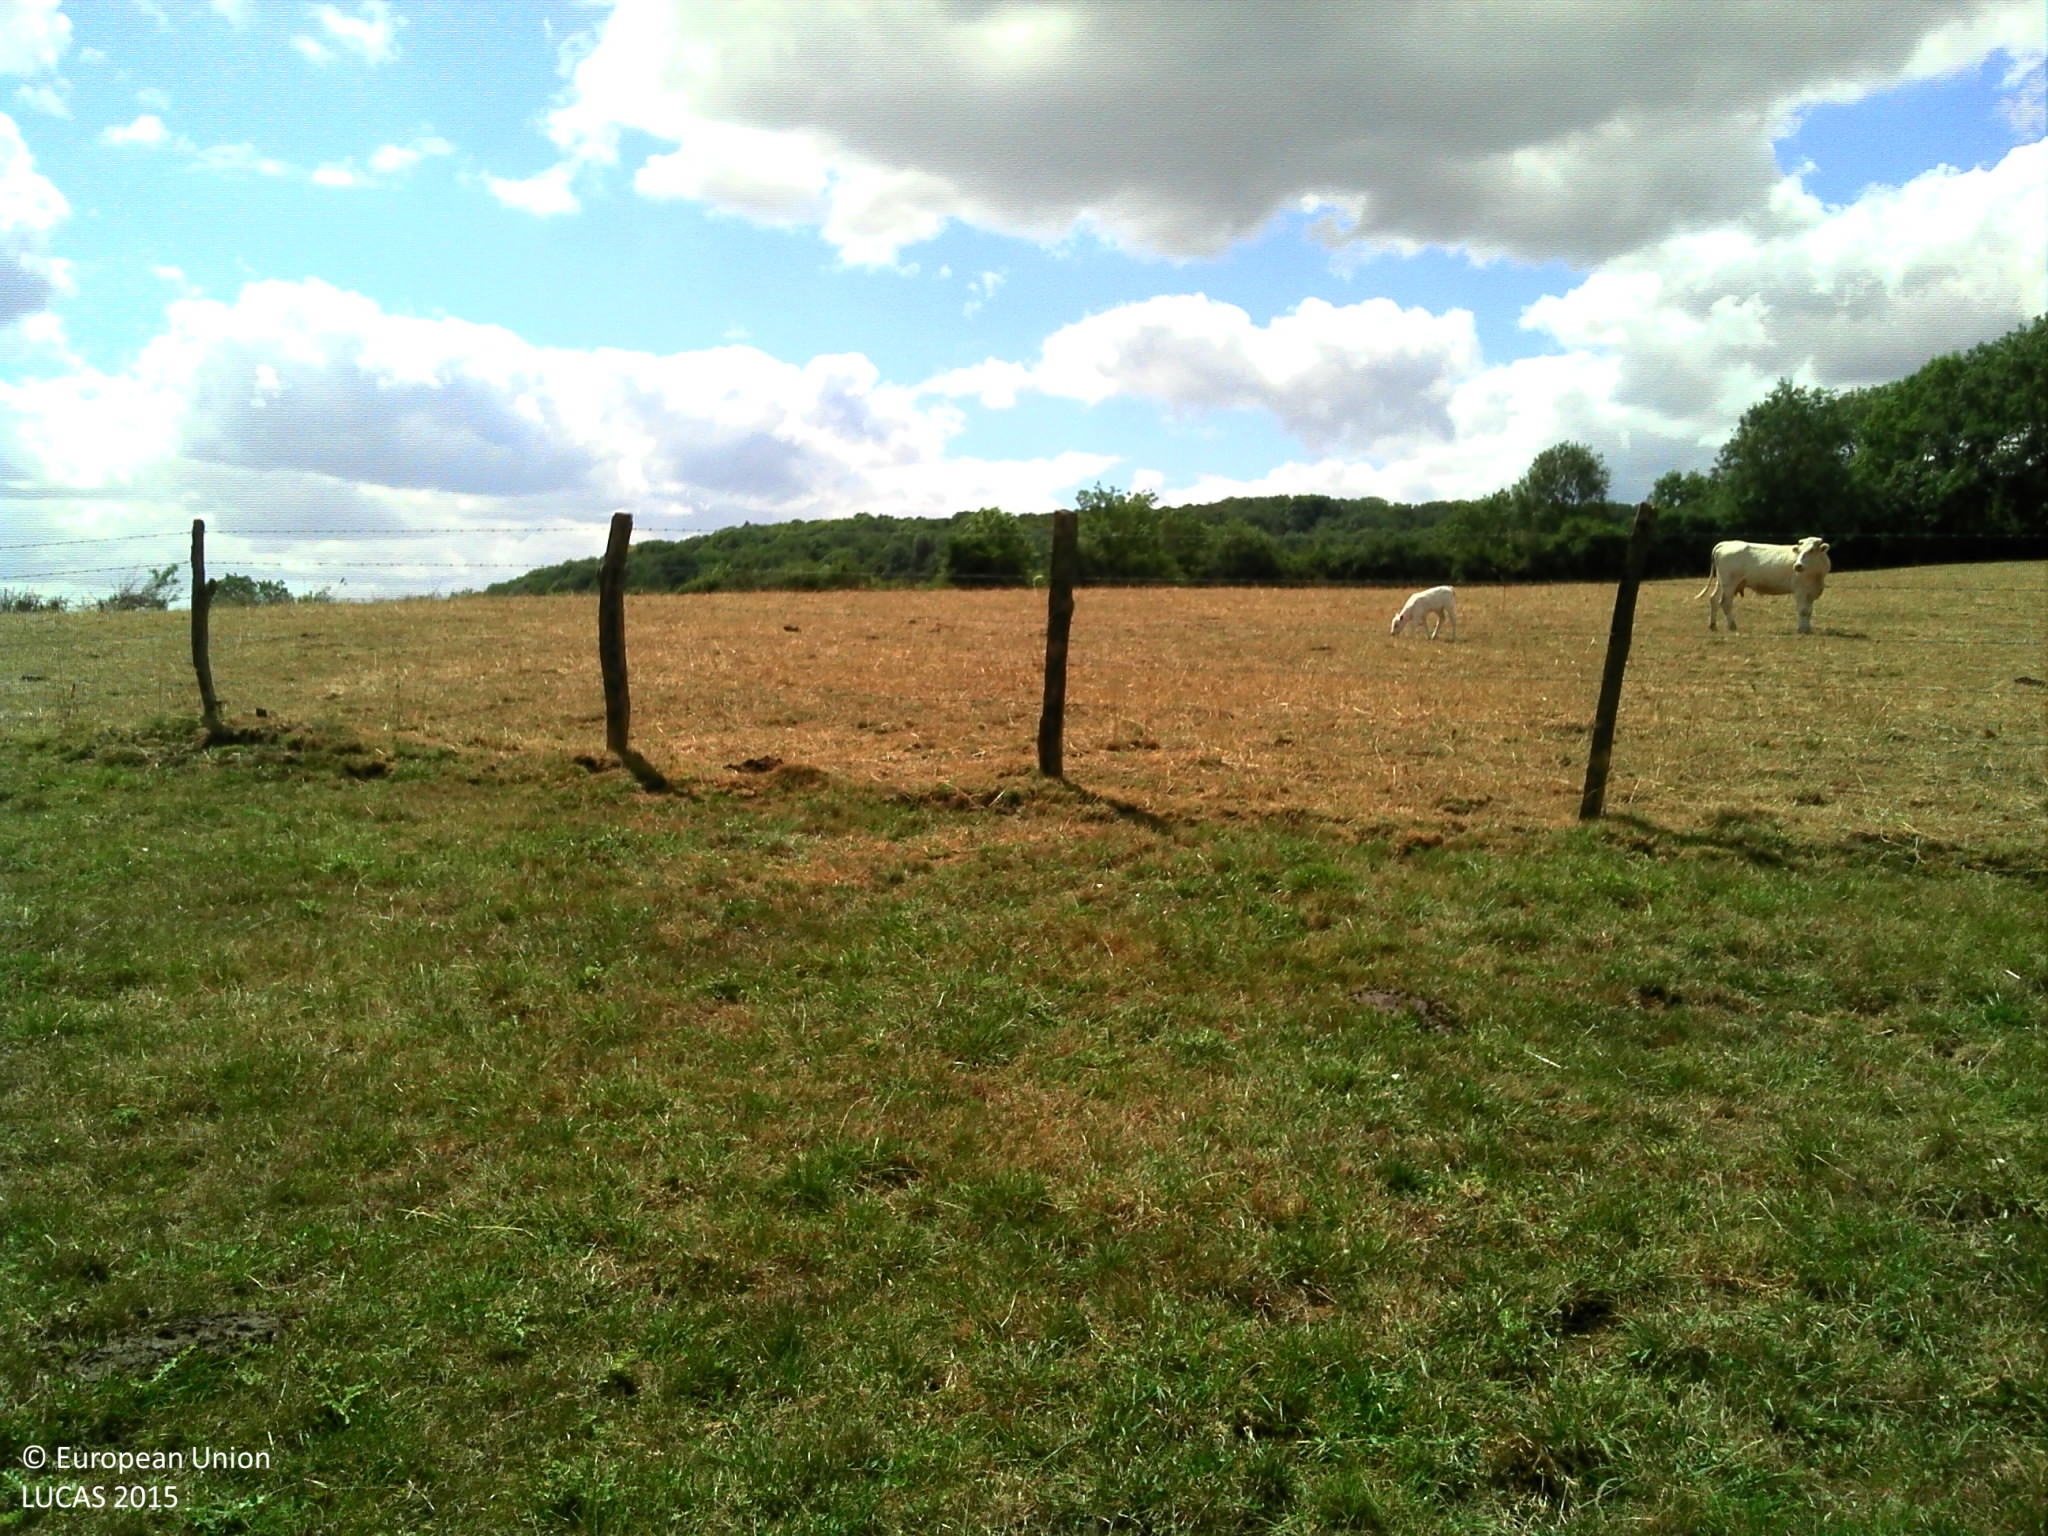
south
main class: Grassland
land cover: Grassland without tree/shrub cover
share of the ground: > 75 %
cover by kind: herbaceous plants 100 %
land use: Agriculture (excluding fallow land and kitchen gardens)
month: July
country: FR
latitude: 47.7792
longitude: 5.2622
